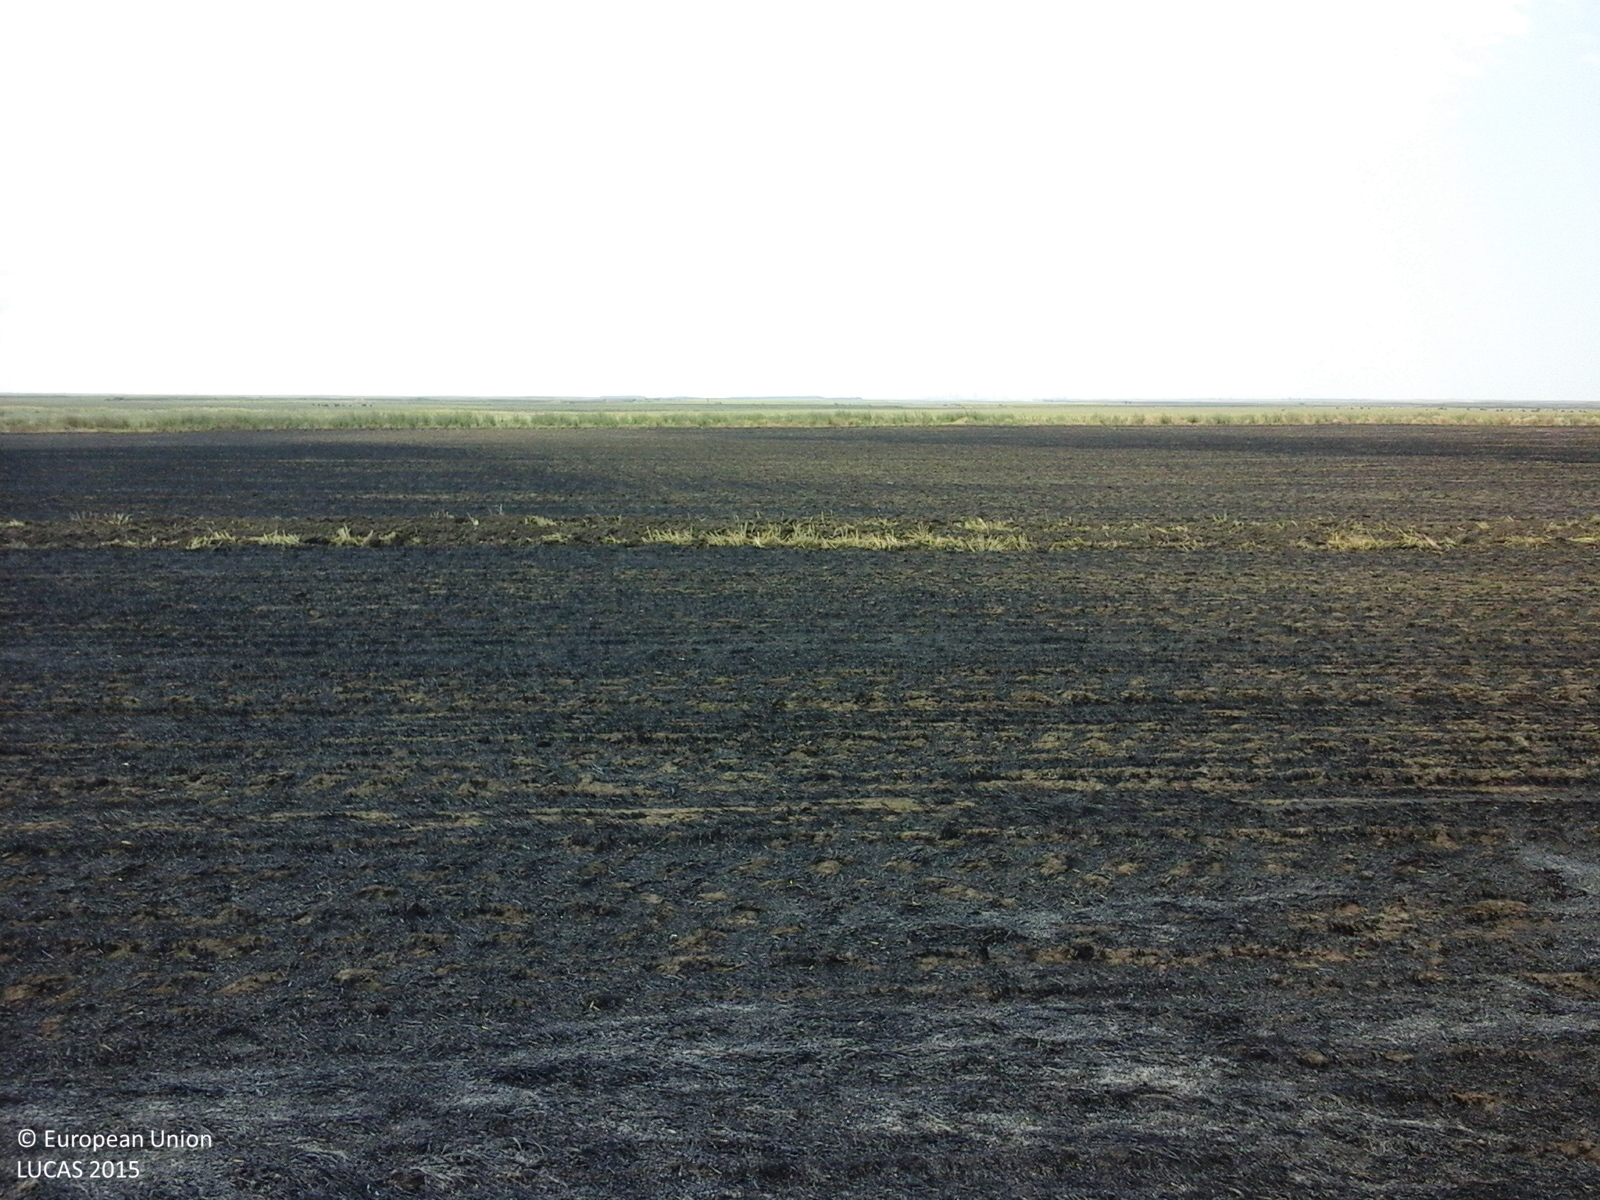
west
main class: Cropland
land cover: Common wheat
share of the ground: < 10 %
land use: Agriculture (excluding fallow land and kitchen gardens)
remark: Burnt area
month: July
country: RO
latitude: 44.5139
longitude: 27.5683
